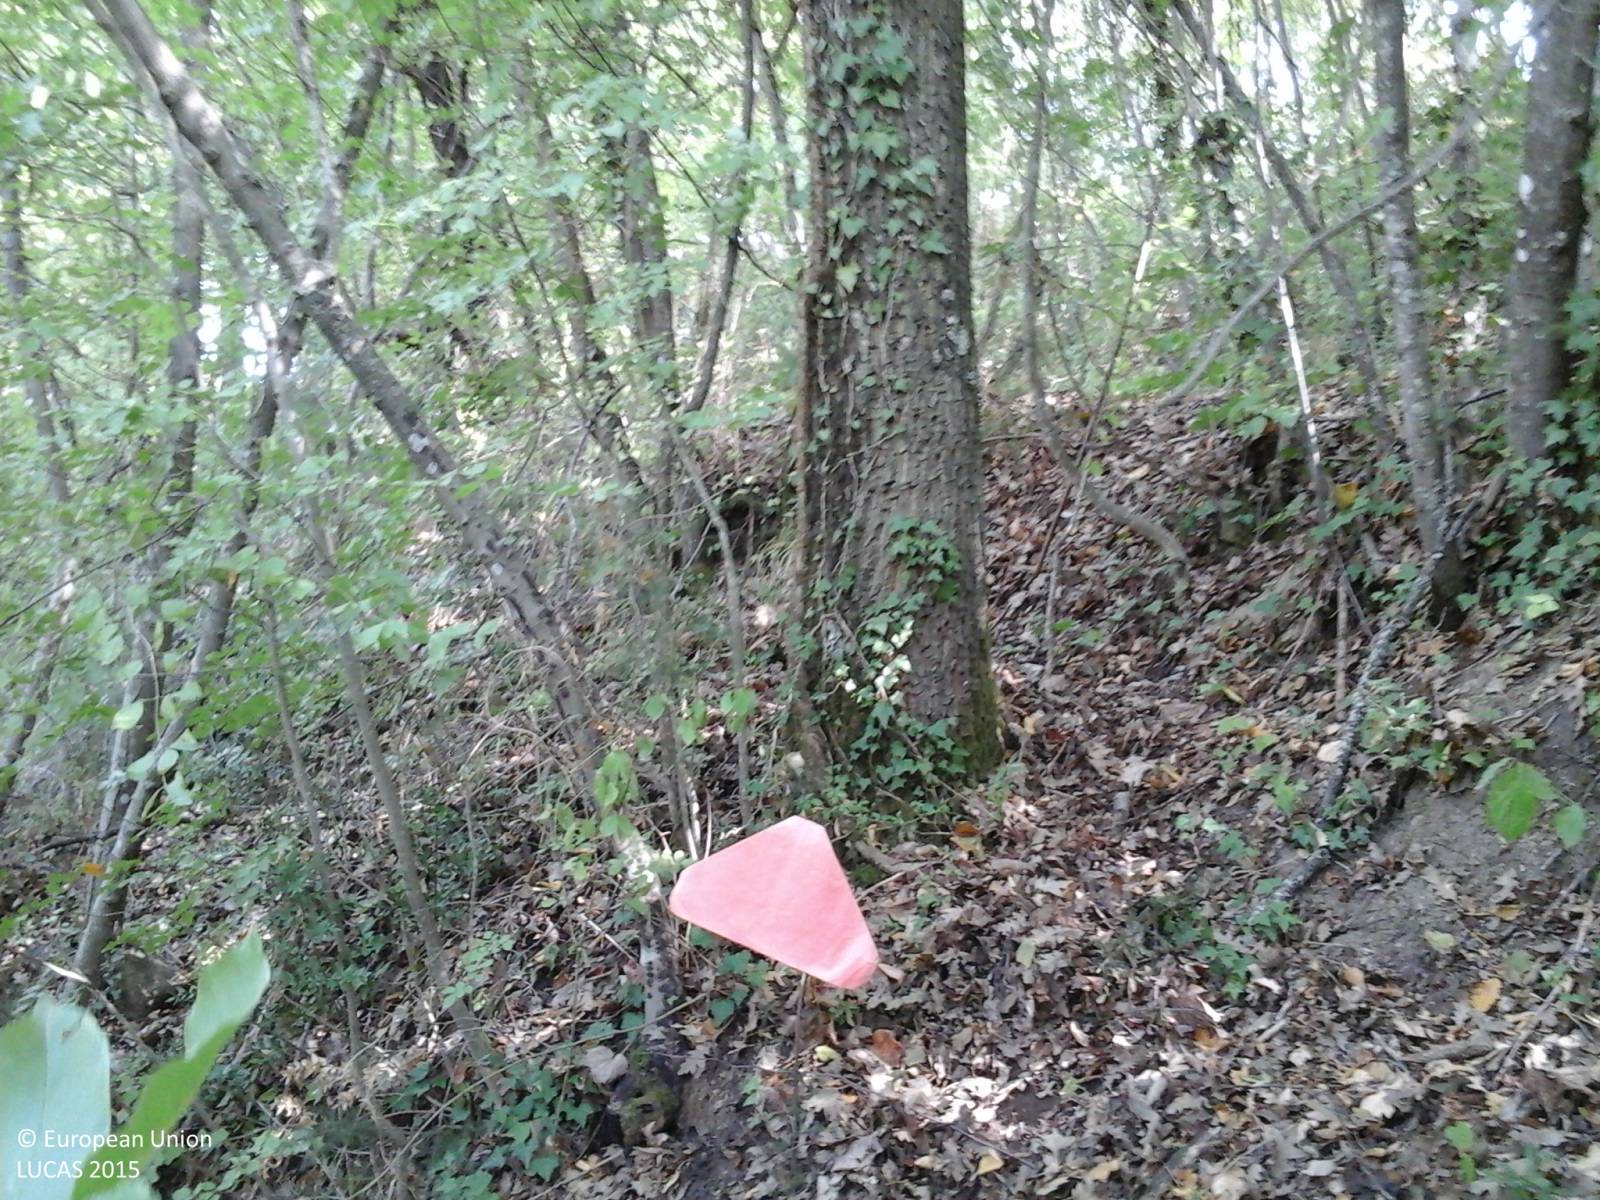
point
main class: Woodland
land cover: Broadleaved woodland
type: thermophilous deciduous forest
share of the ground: > 75 %
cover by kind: broadleaved forest trees 100 %
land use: Forestry
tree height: > 5 m
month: September
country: IT
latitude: 42.9290
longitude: 12.5532
